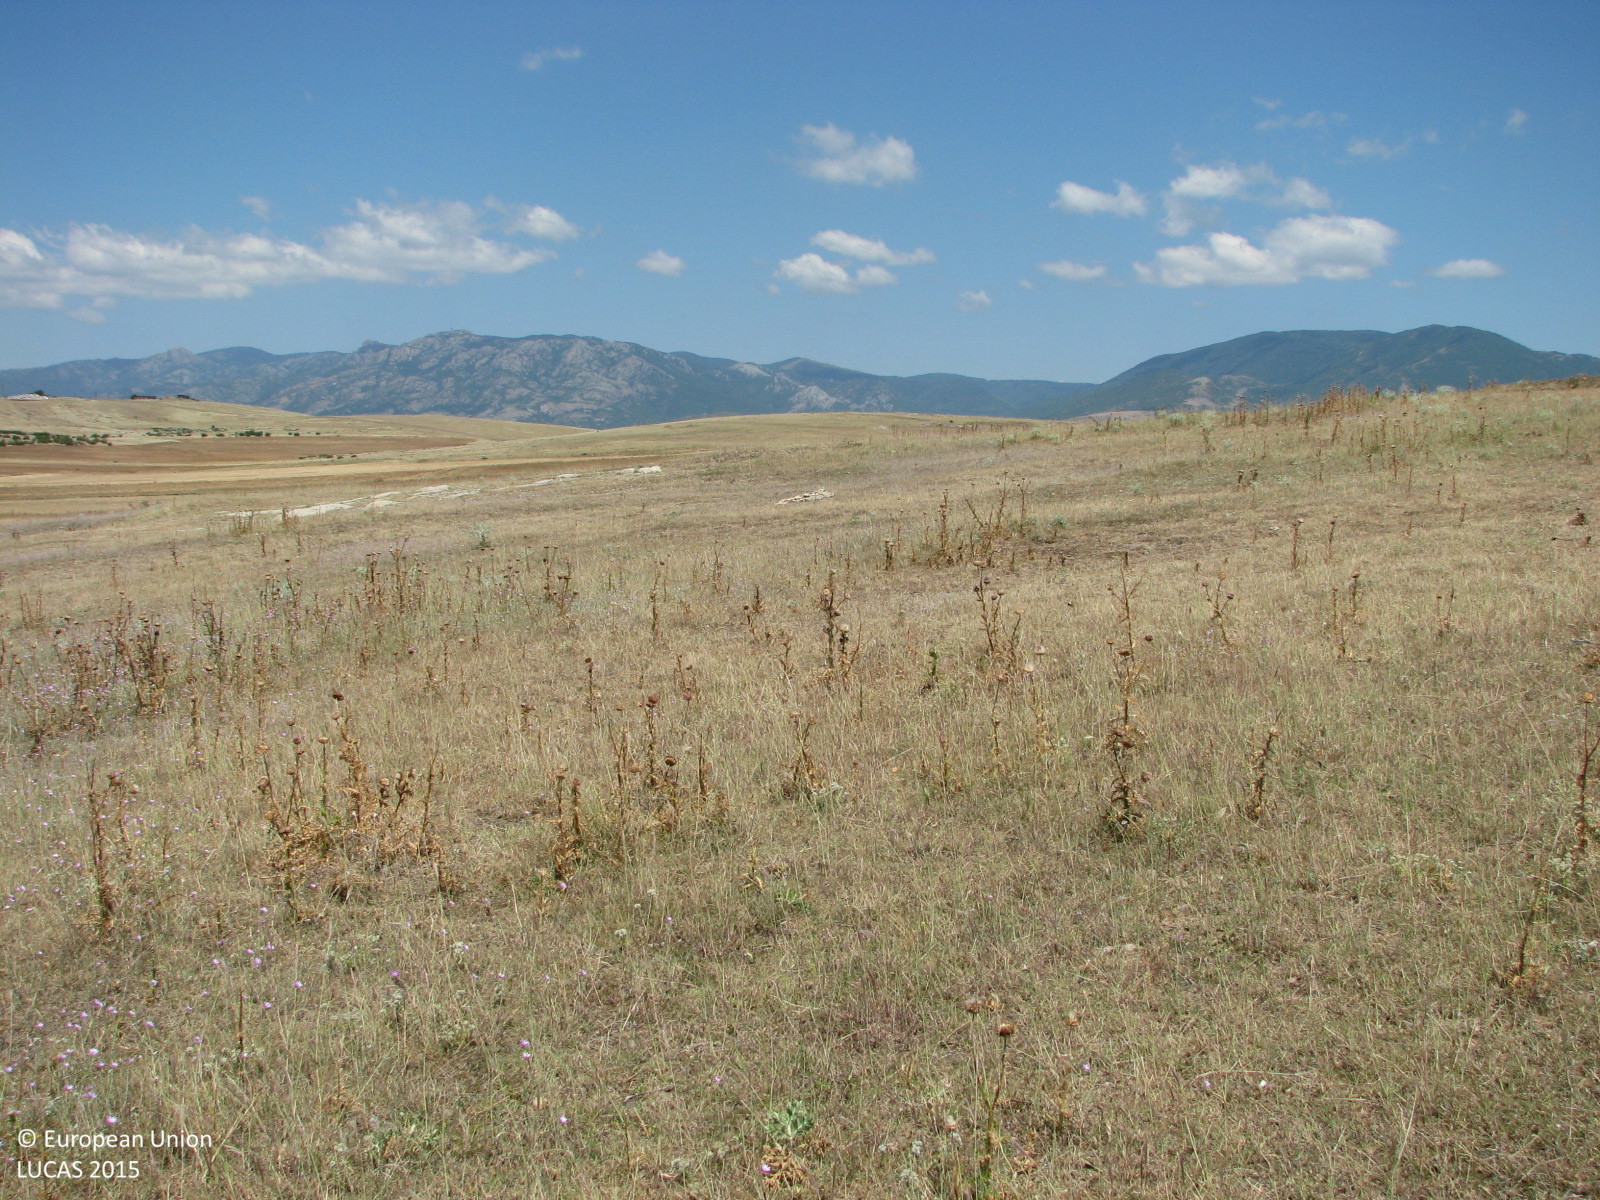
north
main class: Grassland
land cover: Grassland without tree/shrub cover
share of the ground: > 75 %
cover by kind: herbaceous plants 90 %, unconsolidated bare surface 10 %
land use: Semi-natural and natural areas not in use
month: July
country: BG
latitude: 42.6099
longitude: 26.4139
